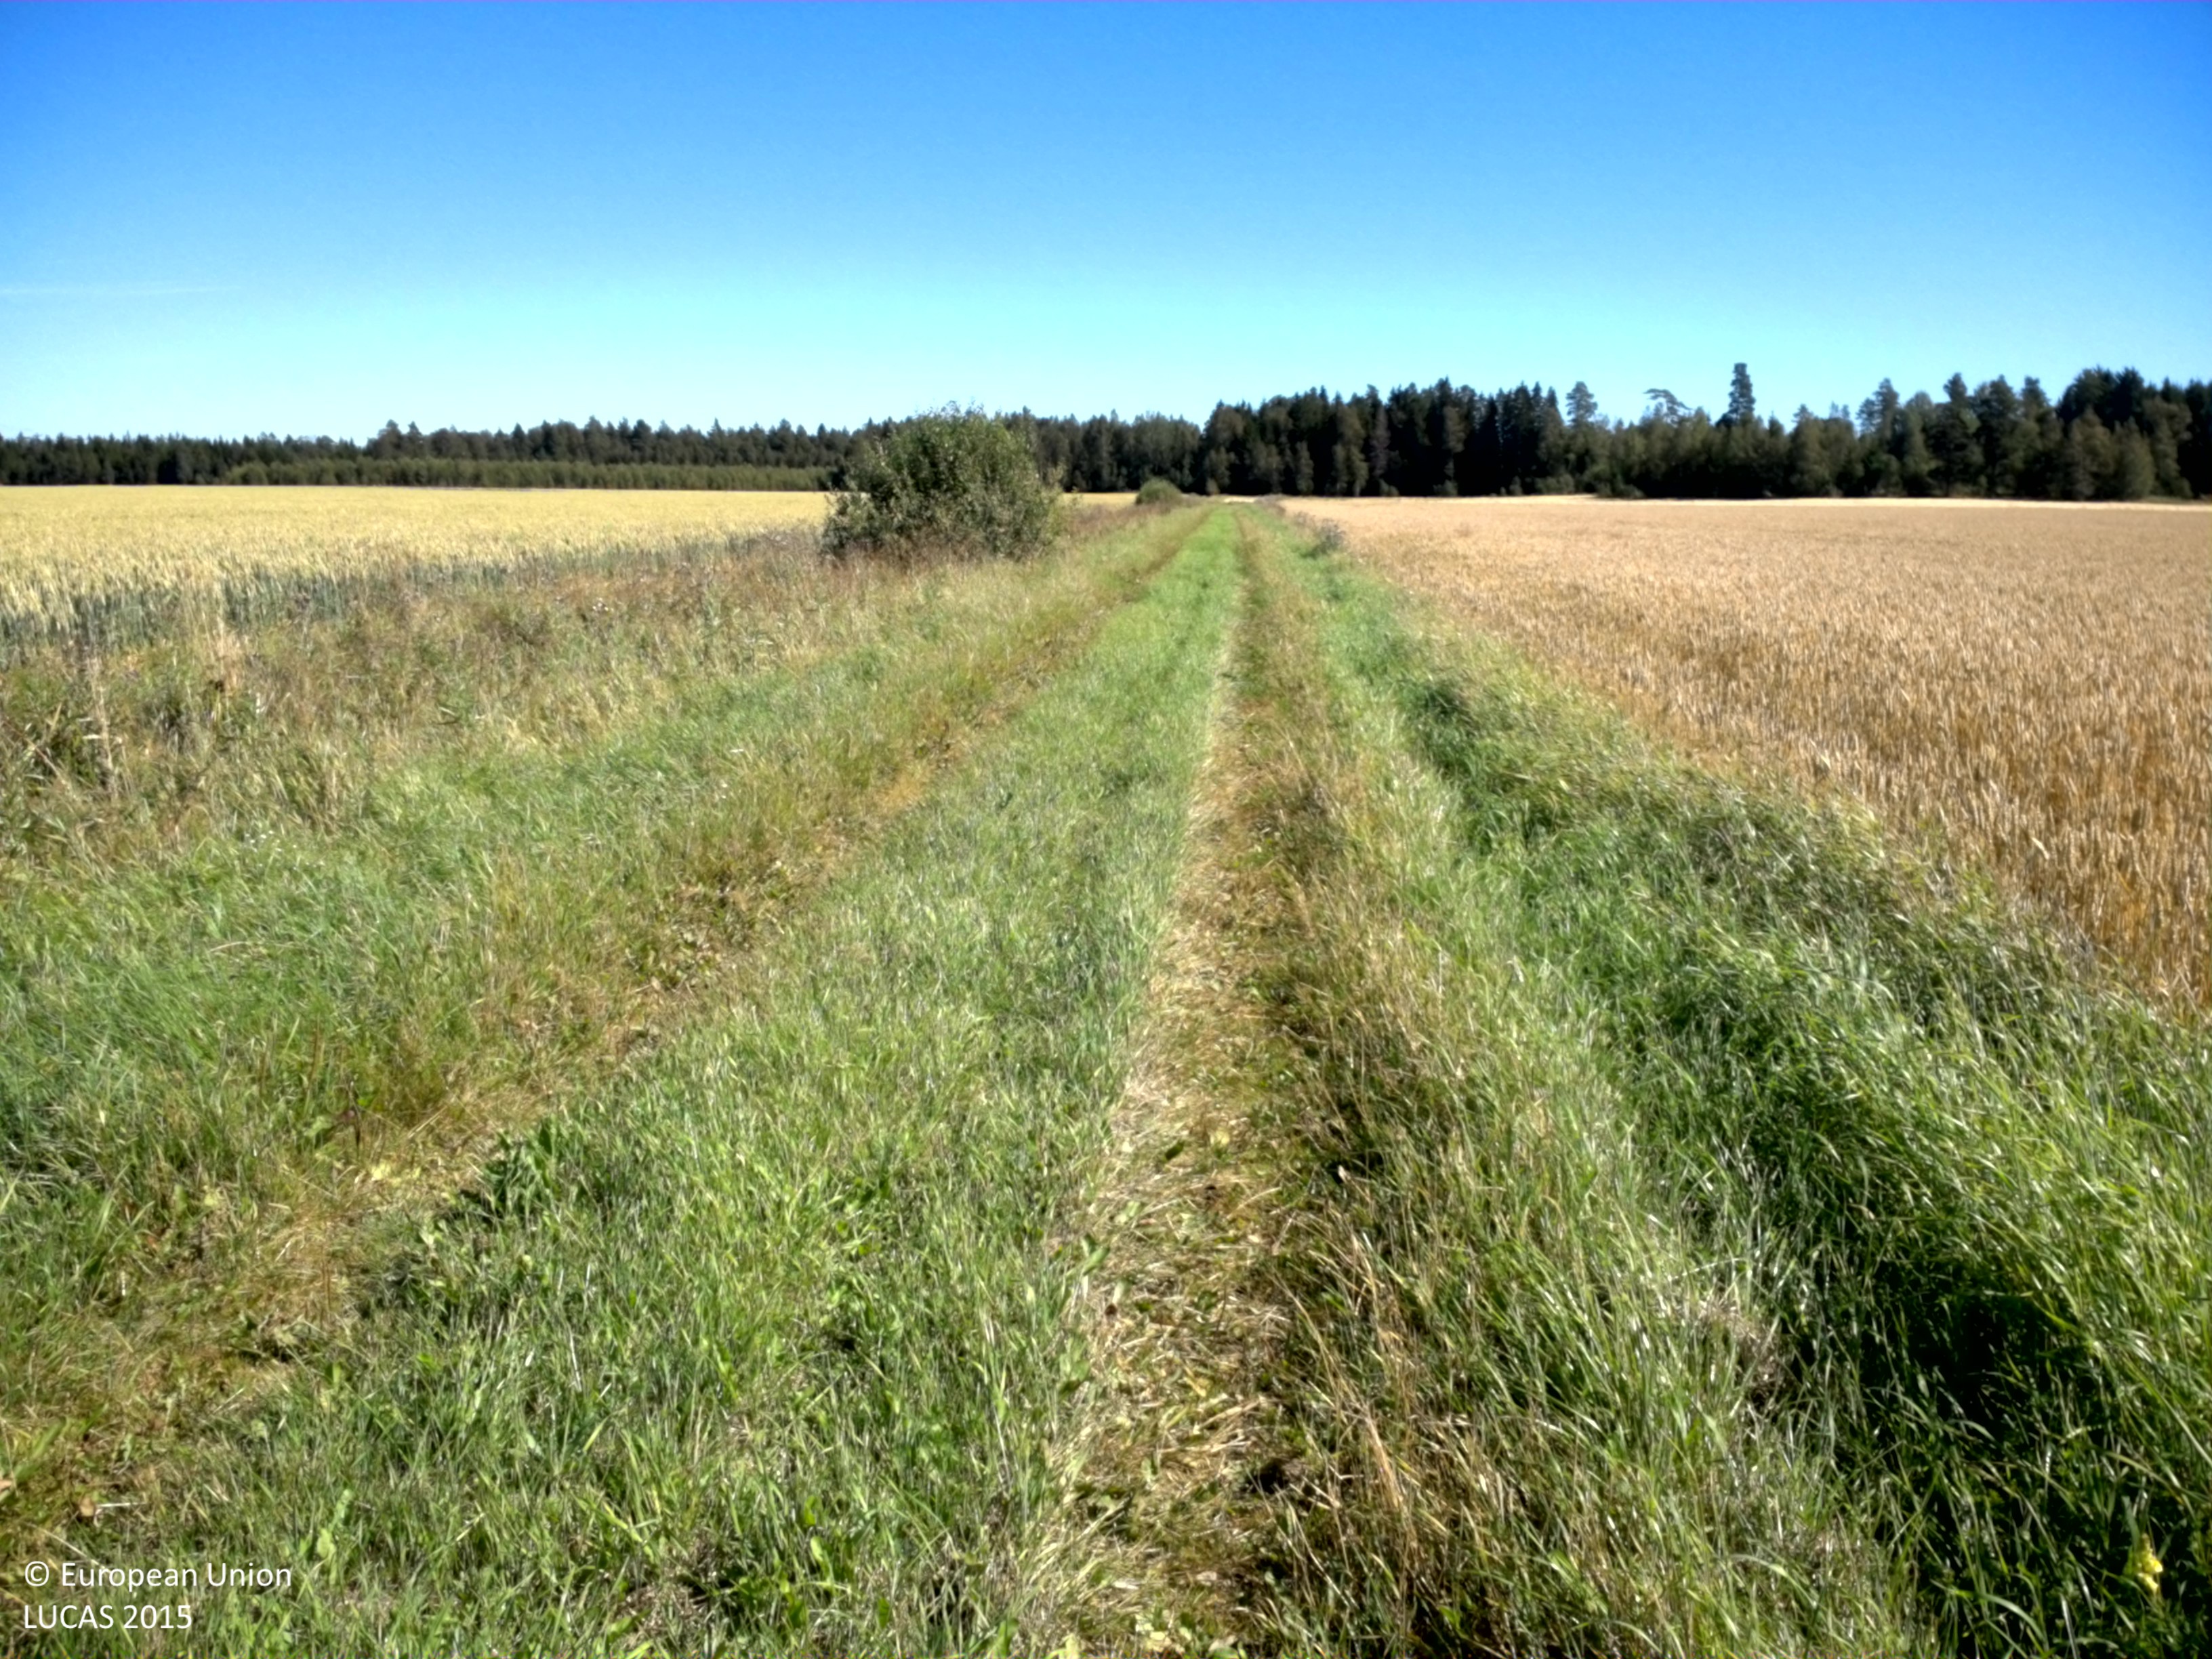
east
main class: Cropland
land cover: Common wheat
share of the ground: > 75 %
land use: Agriculture (excluding fallow land and kitchen gardens)
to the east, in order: Common wheat; Grass margins; Ditches and canals; Grass margins; Common wheat
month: August
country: SE
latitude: 60.1301
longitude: 17.0657
